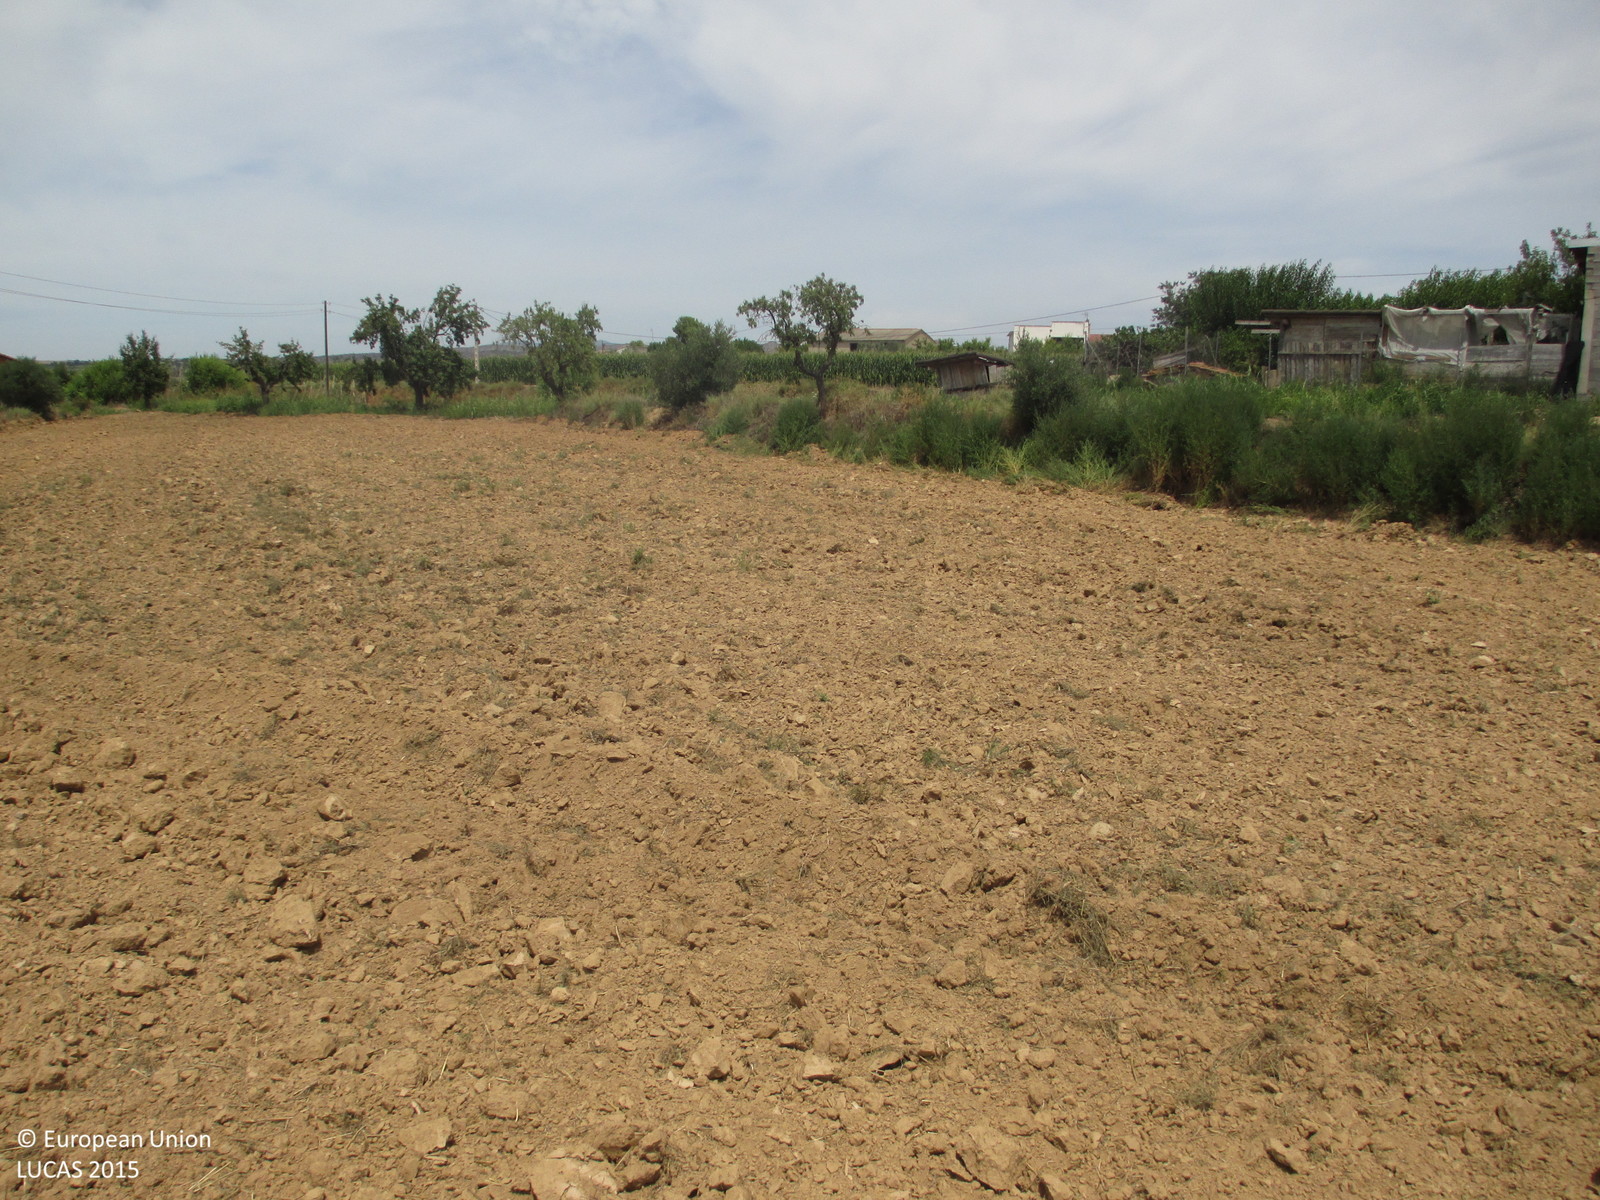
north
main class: Cropland
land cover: Maize
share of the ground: > 75 %
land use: Agriculture (excluding fallow land and kitchen gardens)
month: July
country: ES
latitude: 41.8612
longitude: 0.3107
